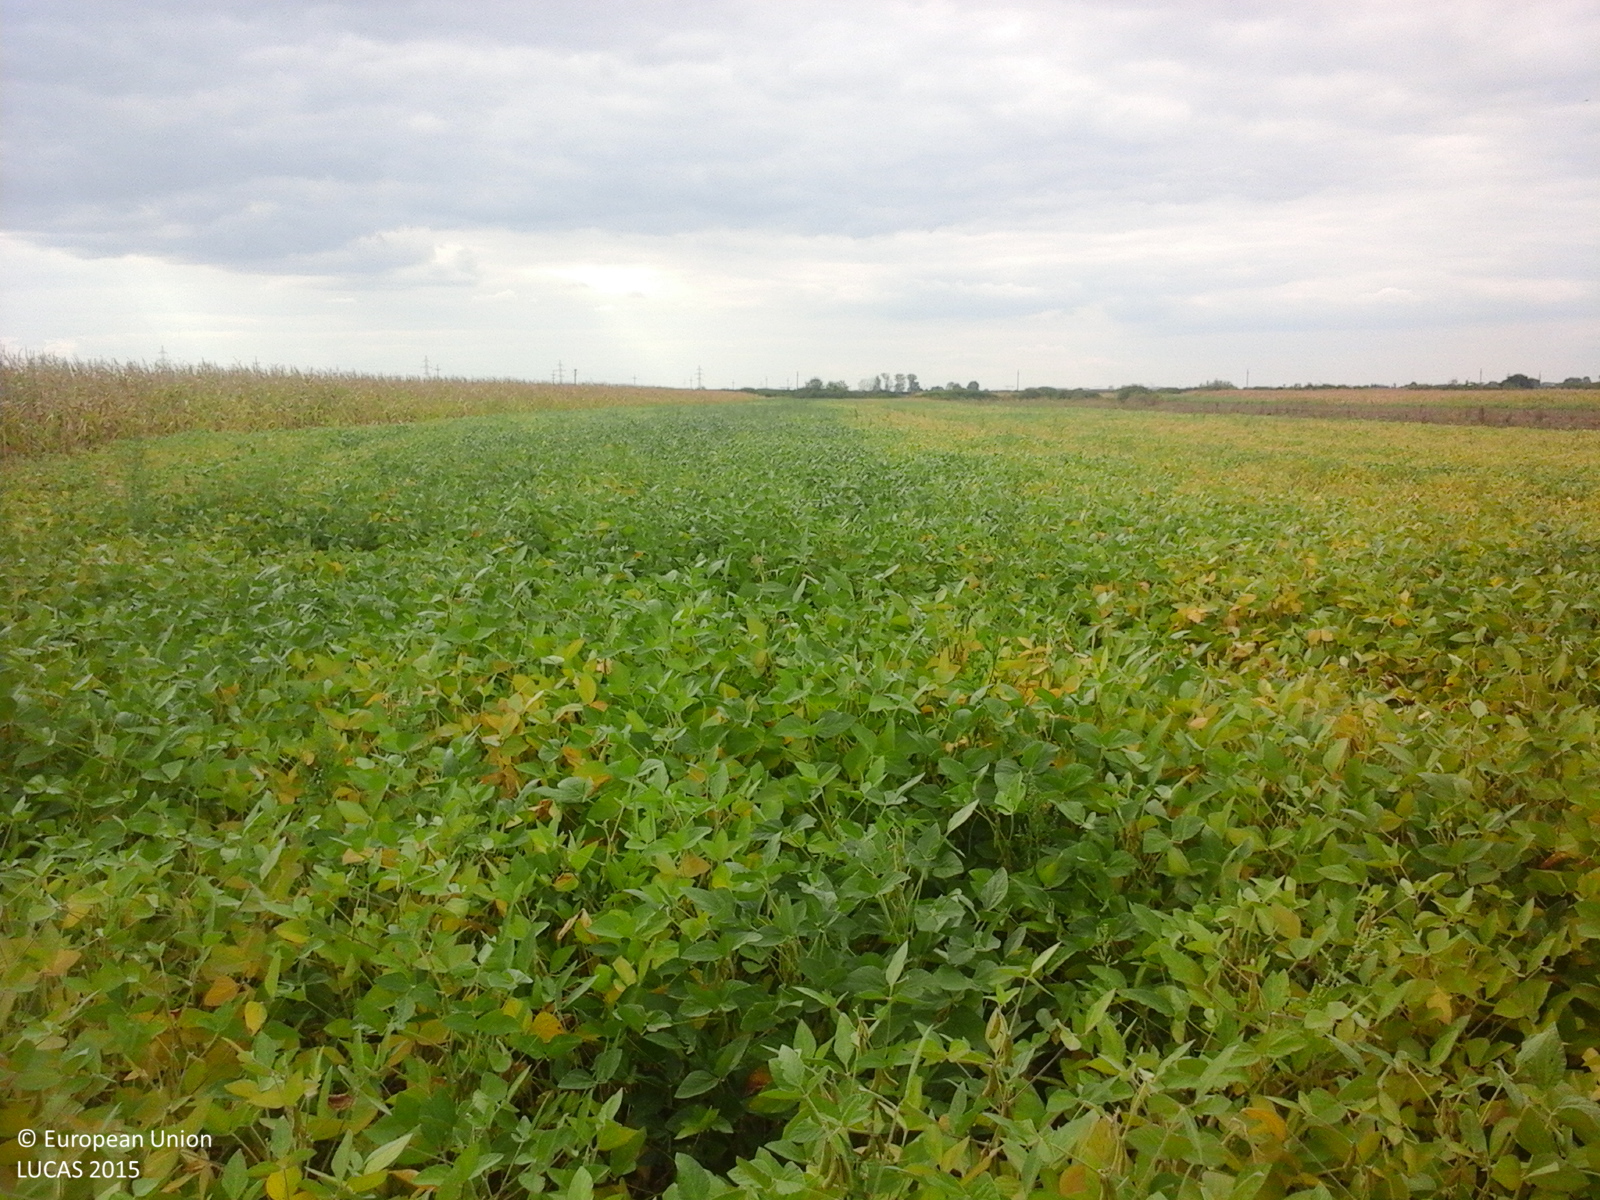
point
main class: Cropland
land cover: Soya
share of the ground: > 75 %
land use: Agriculture (excluding fallow land and kitchen gardens)
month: September
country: RO
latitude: 47.7635
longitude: 22.9676
